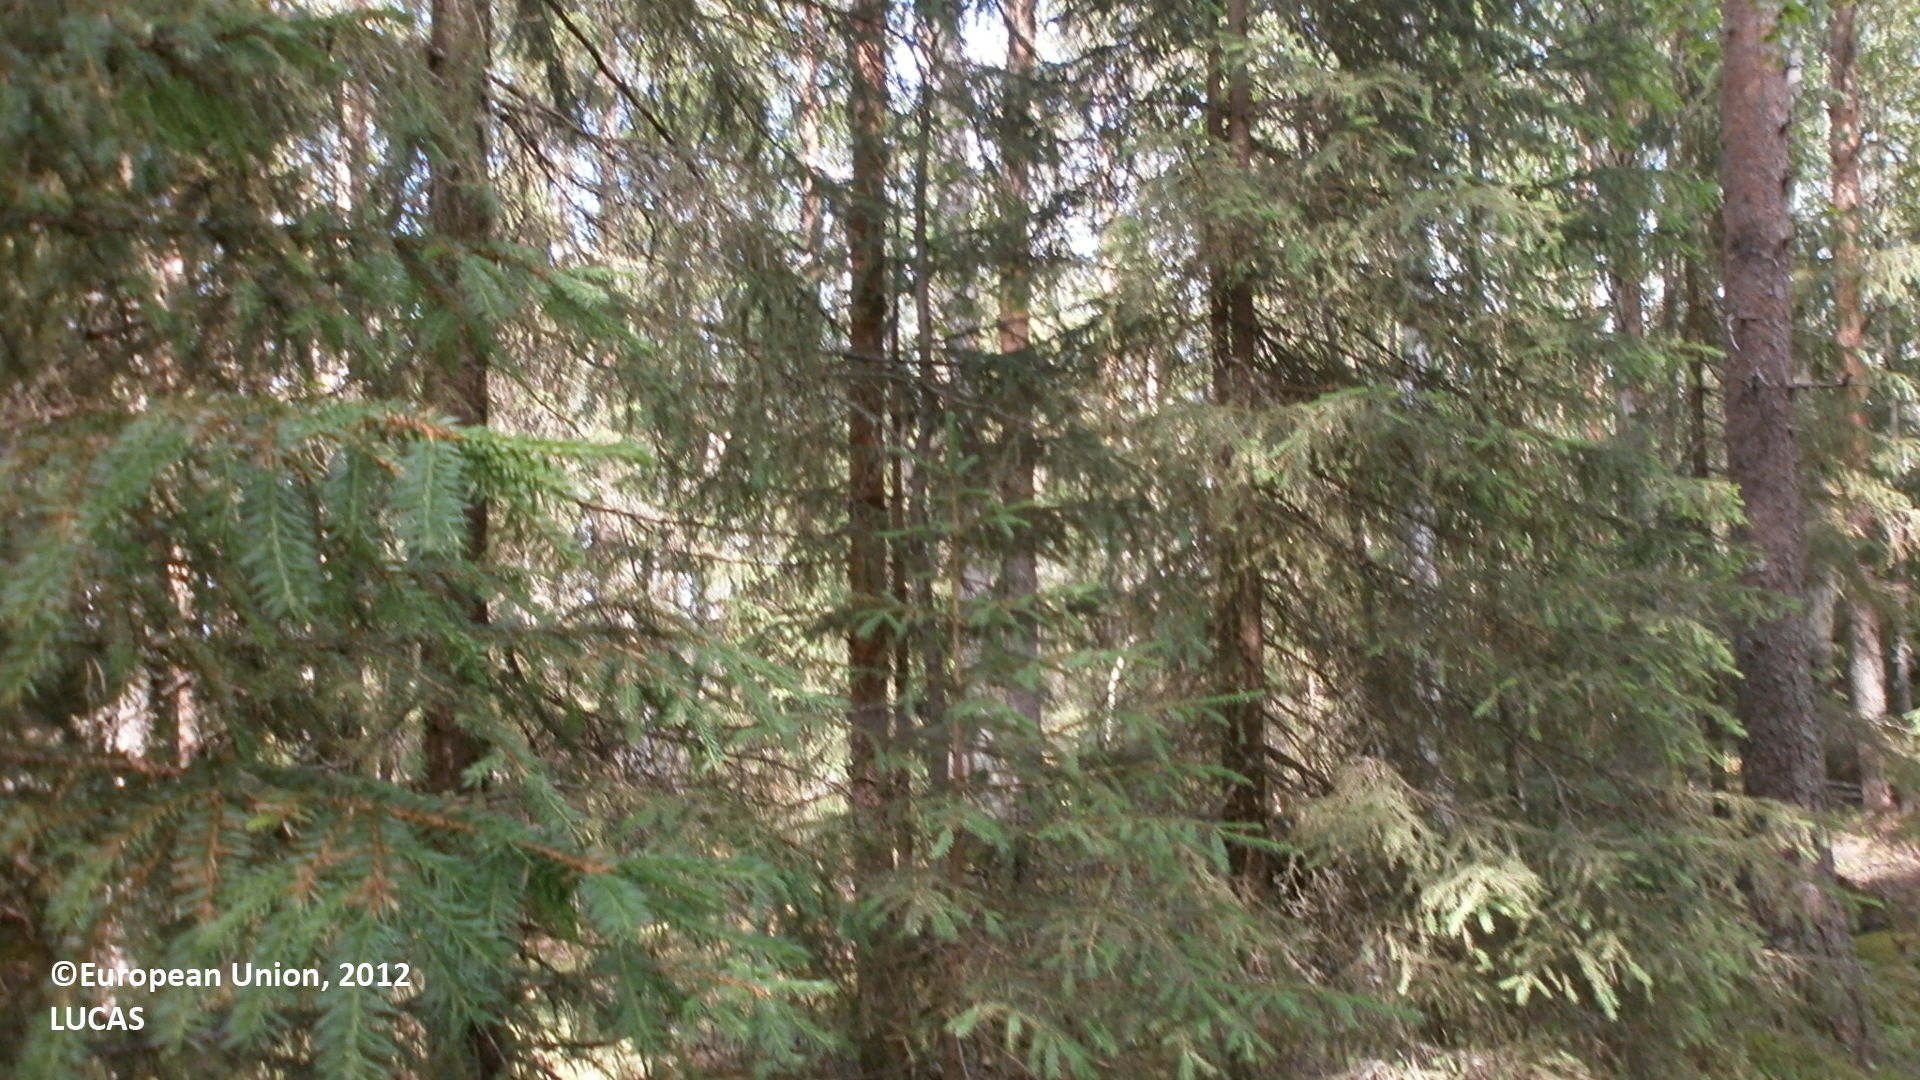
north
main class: Woodland
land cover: Pine dominated mixed woodland
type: boreal forest
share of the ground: > 75 %
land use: Forestry
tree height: > 5 m
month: July
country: FI
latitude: 64.0876
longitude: 24.7850
